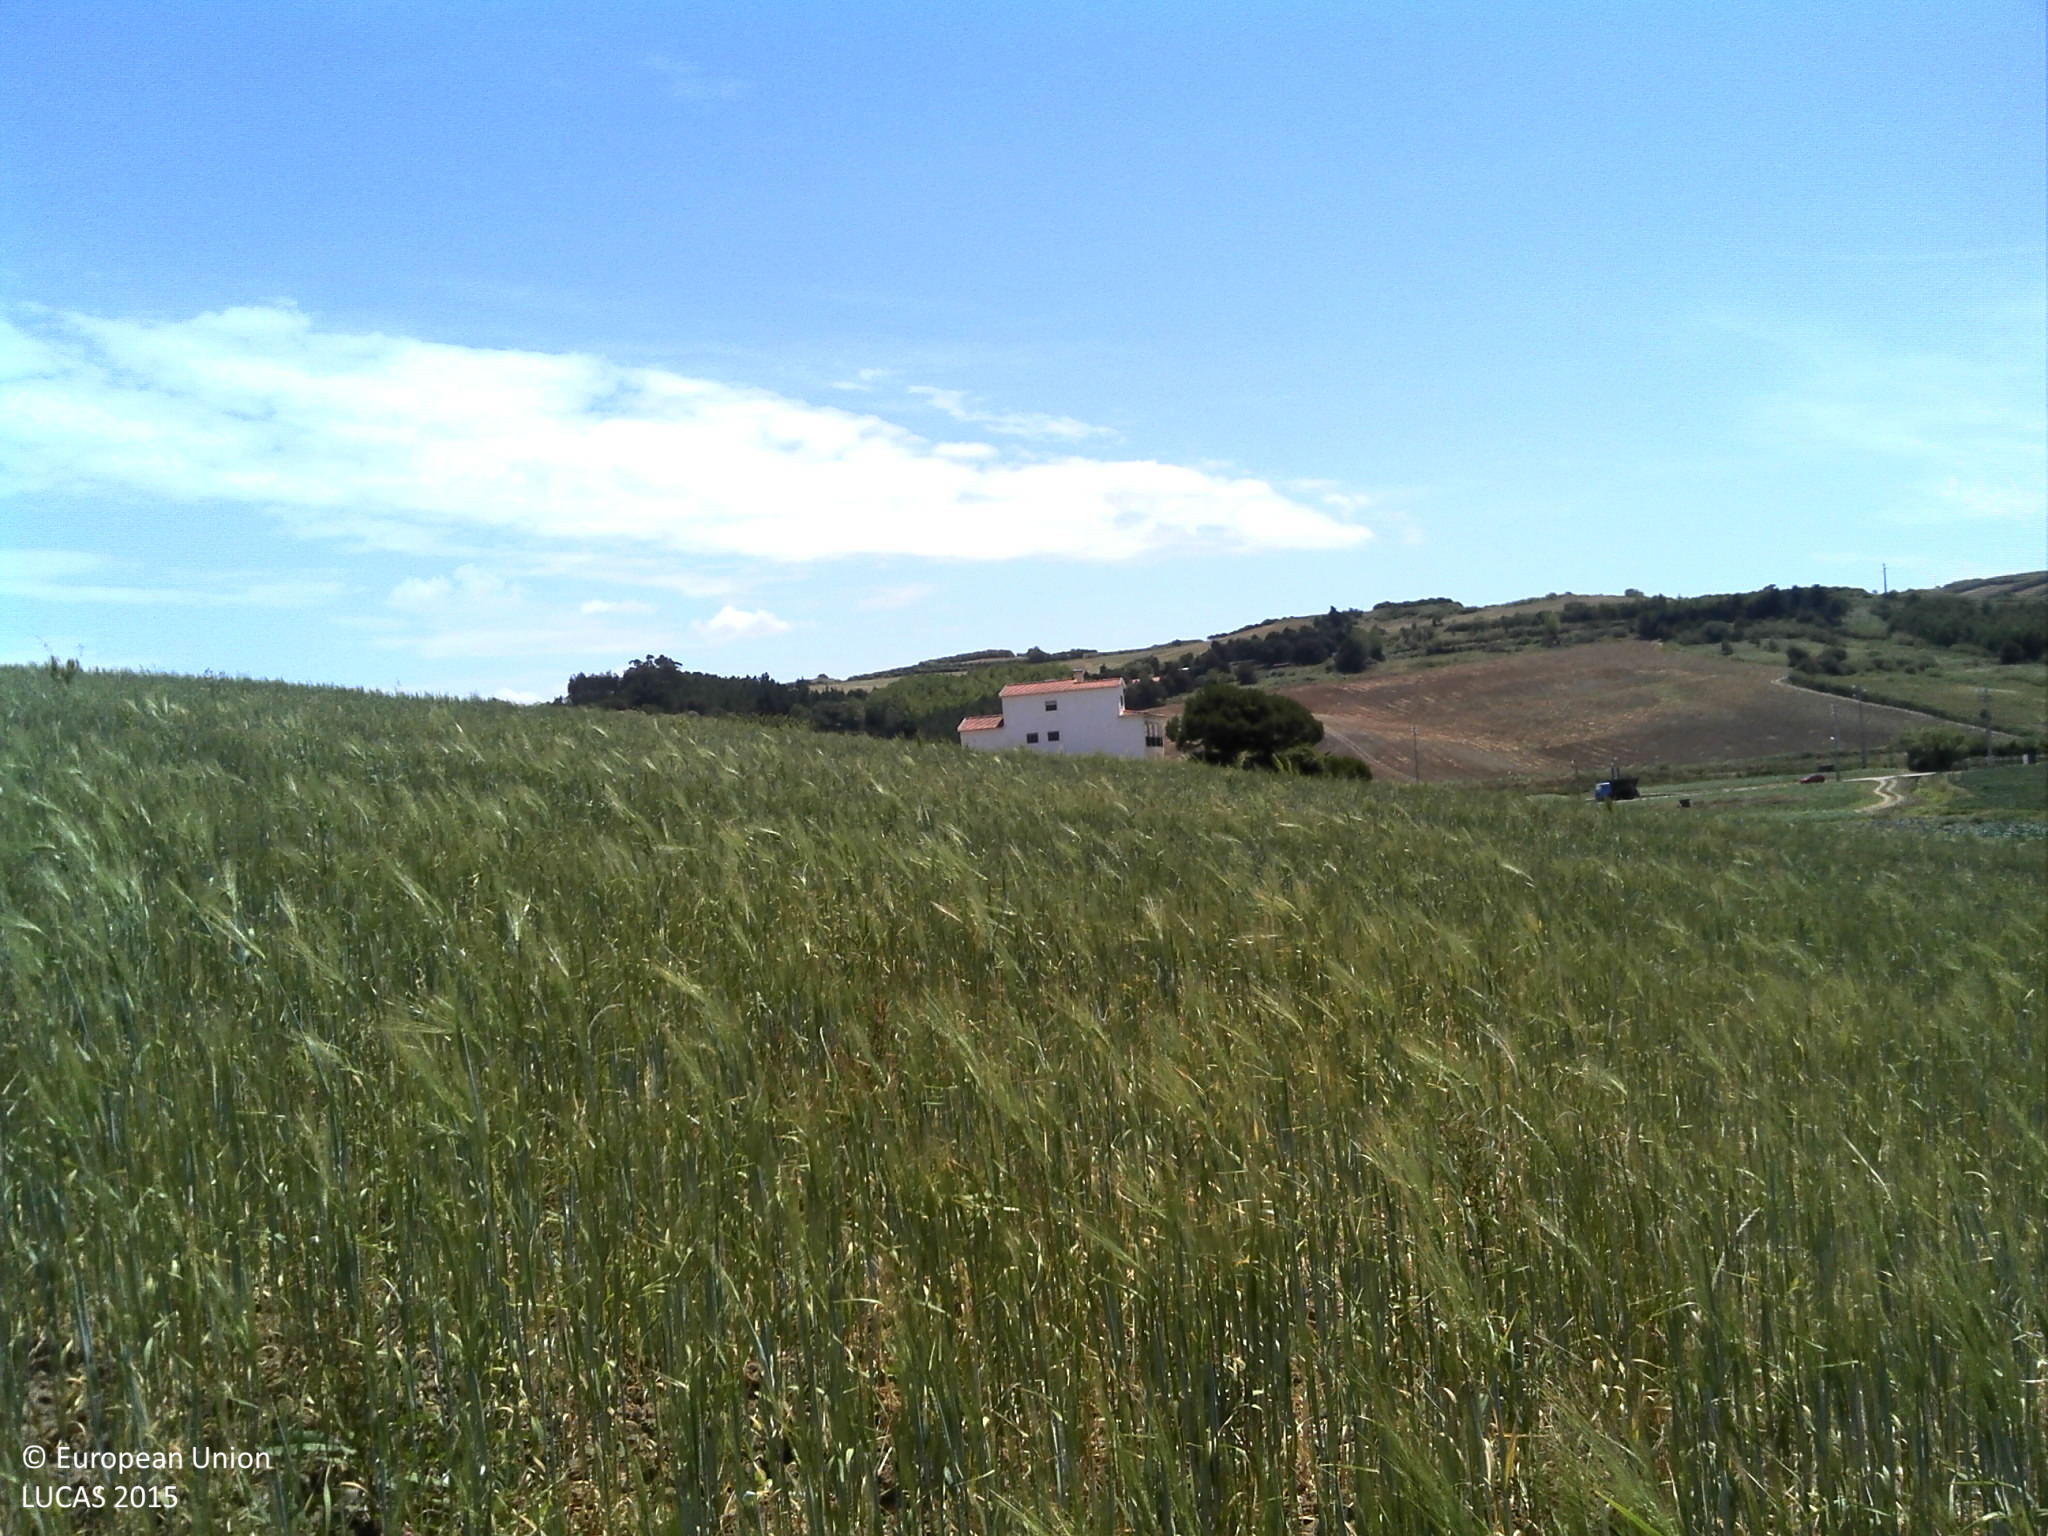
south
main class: Cropland
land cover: Triticale
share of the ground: 50 - 75 %
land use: Agriculture (excluding fallow land and kitchen gardens)
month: June
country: PT
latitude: 39.2411
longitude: -9.2884
